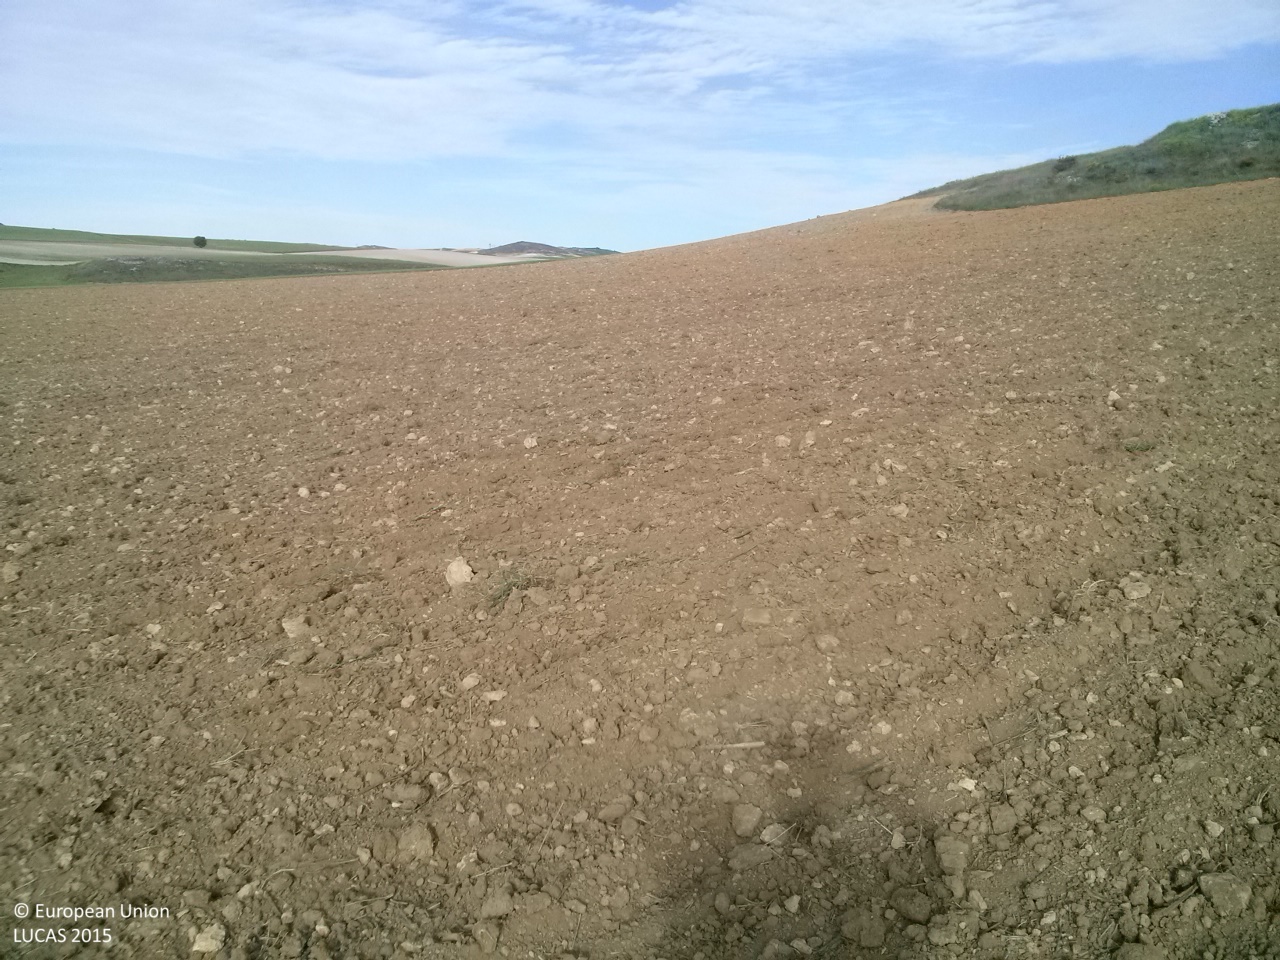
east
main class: Cropland
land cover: Sunflower
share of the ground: < 10 %
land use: Agriculture (excluding fallow land and kitchen gardens)
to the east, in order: Sunflower; Barley; Grass margins; Rock outcrops
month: May
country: ES
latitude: 39.8915
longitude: -2.7316
